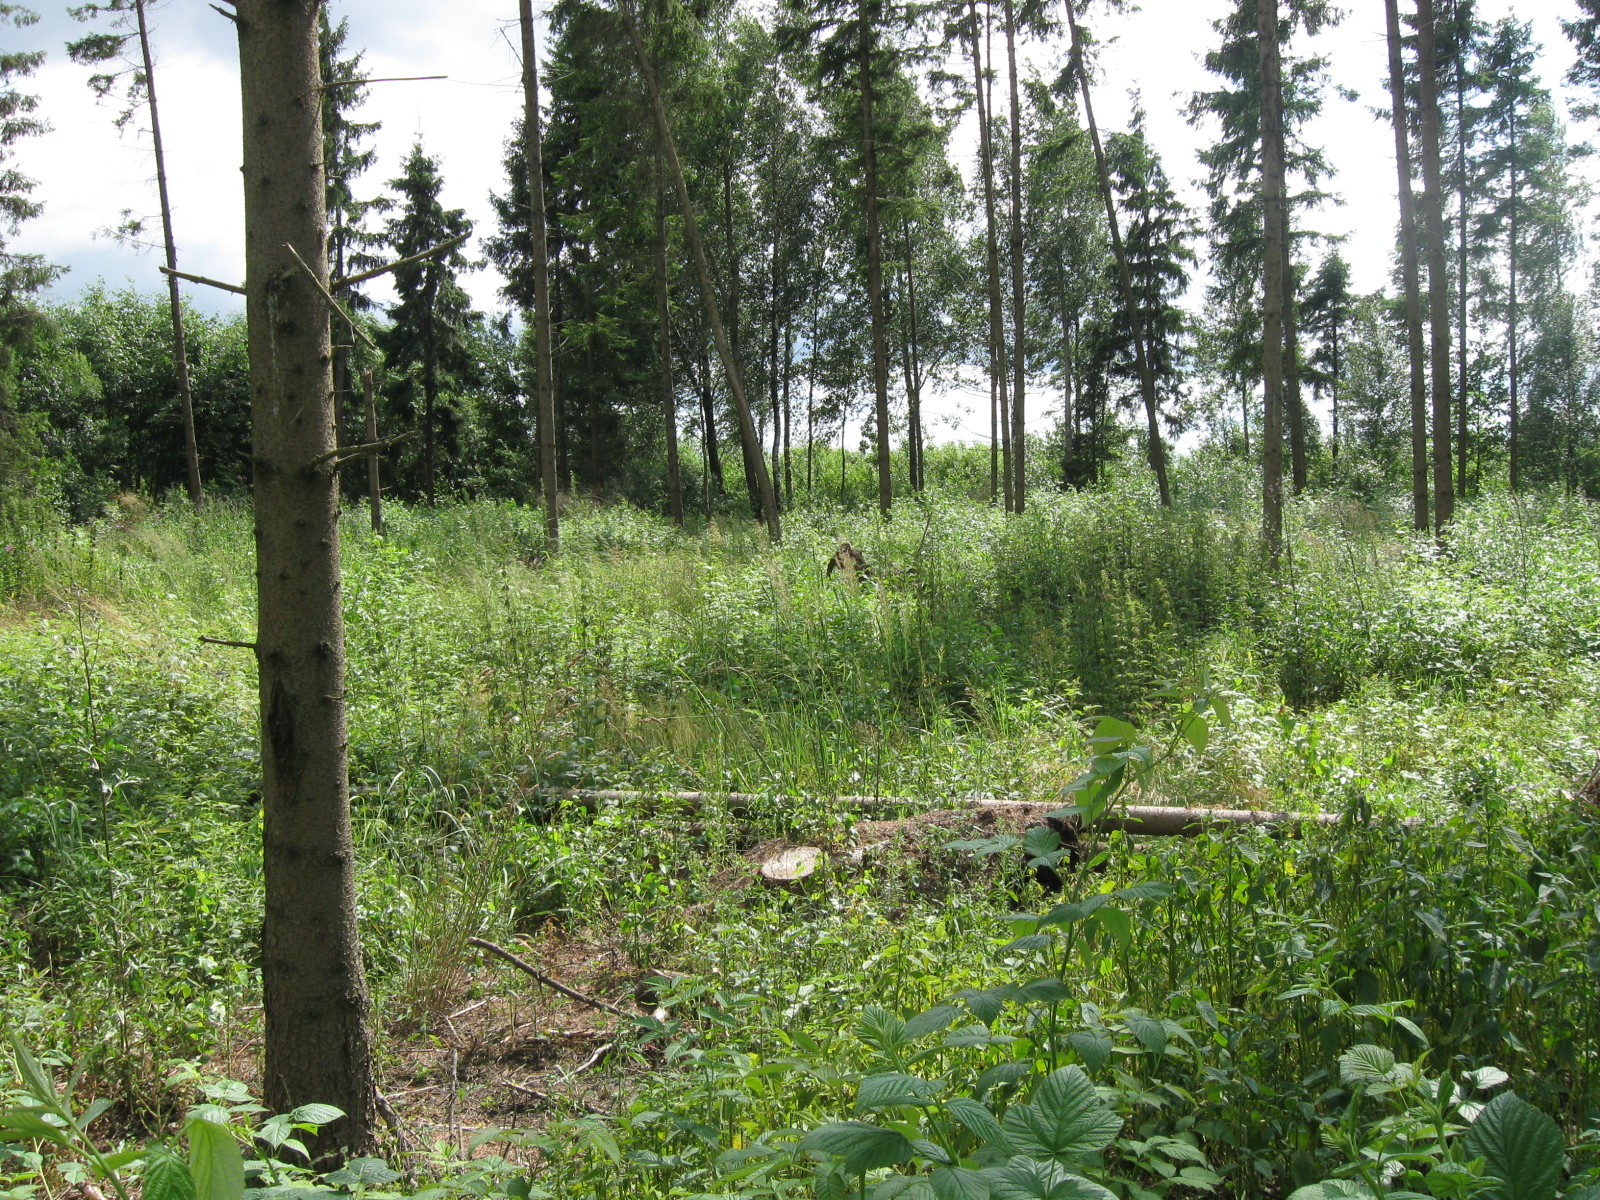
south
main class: Shrubland
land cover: Shrubland with sparse tree cover
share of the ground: 50 - 75 %
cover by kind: herbaceous plants 50 %, shrubs 45 %, coniferous forest trees 5 %
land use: Forestry
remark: Clear cut
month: July
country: LT
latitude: 55.1277
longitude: 23.4569
